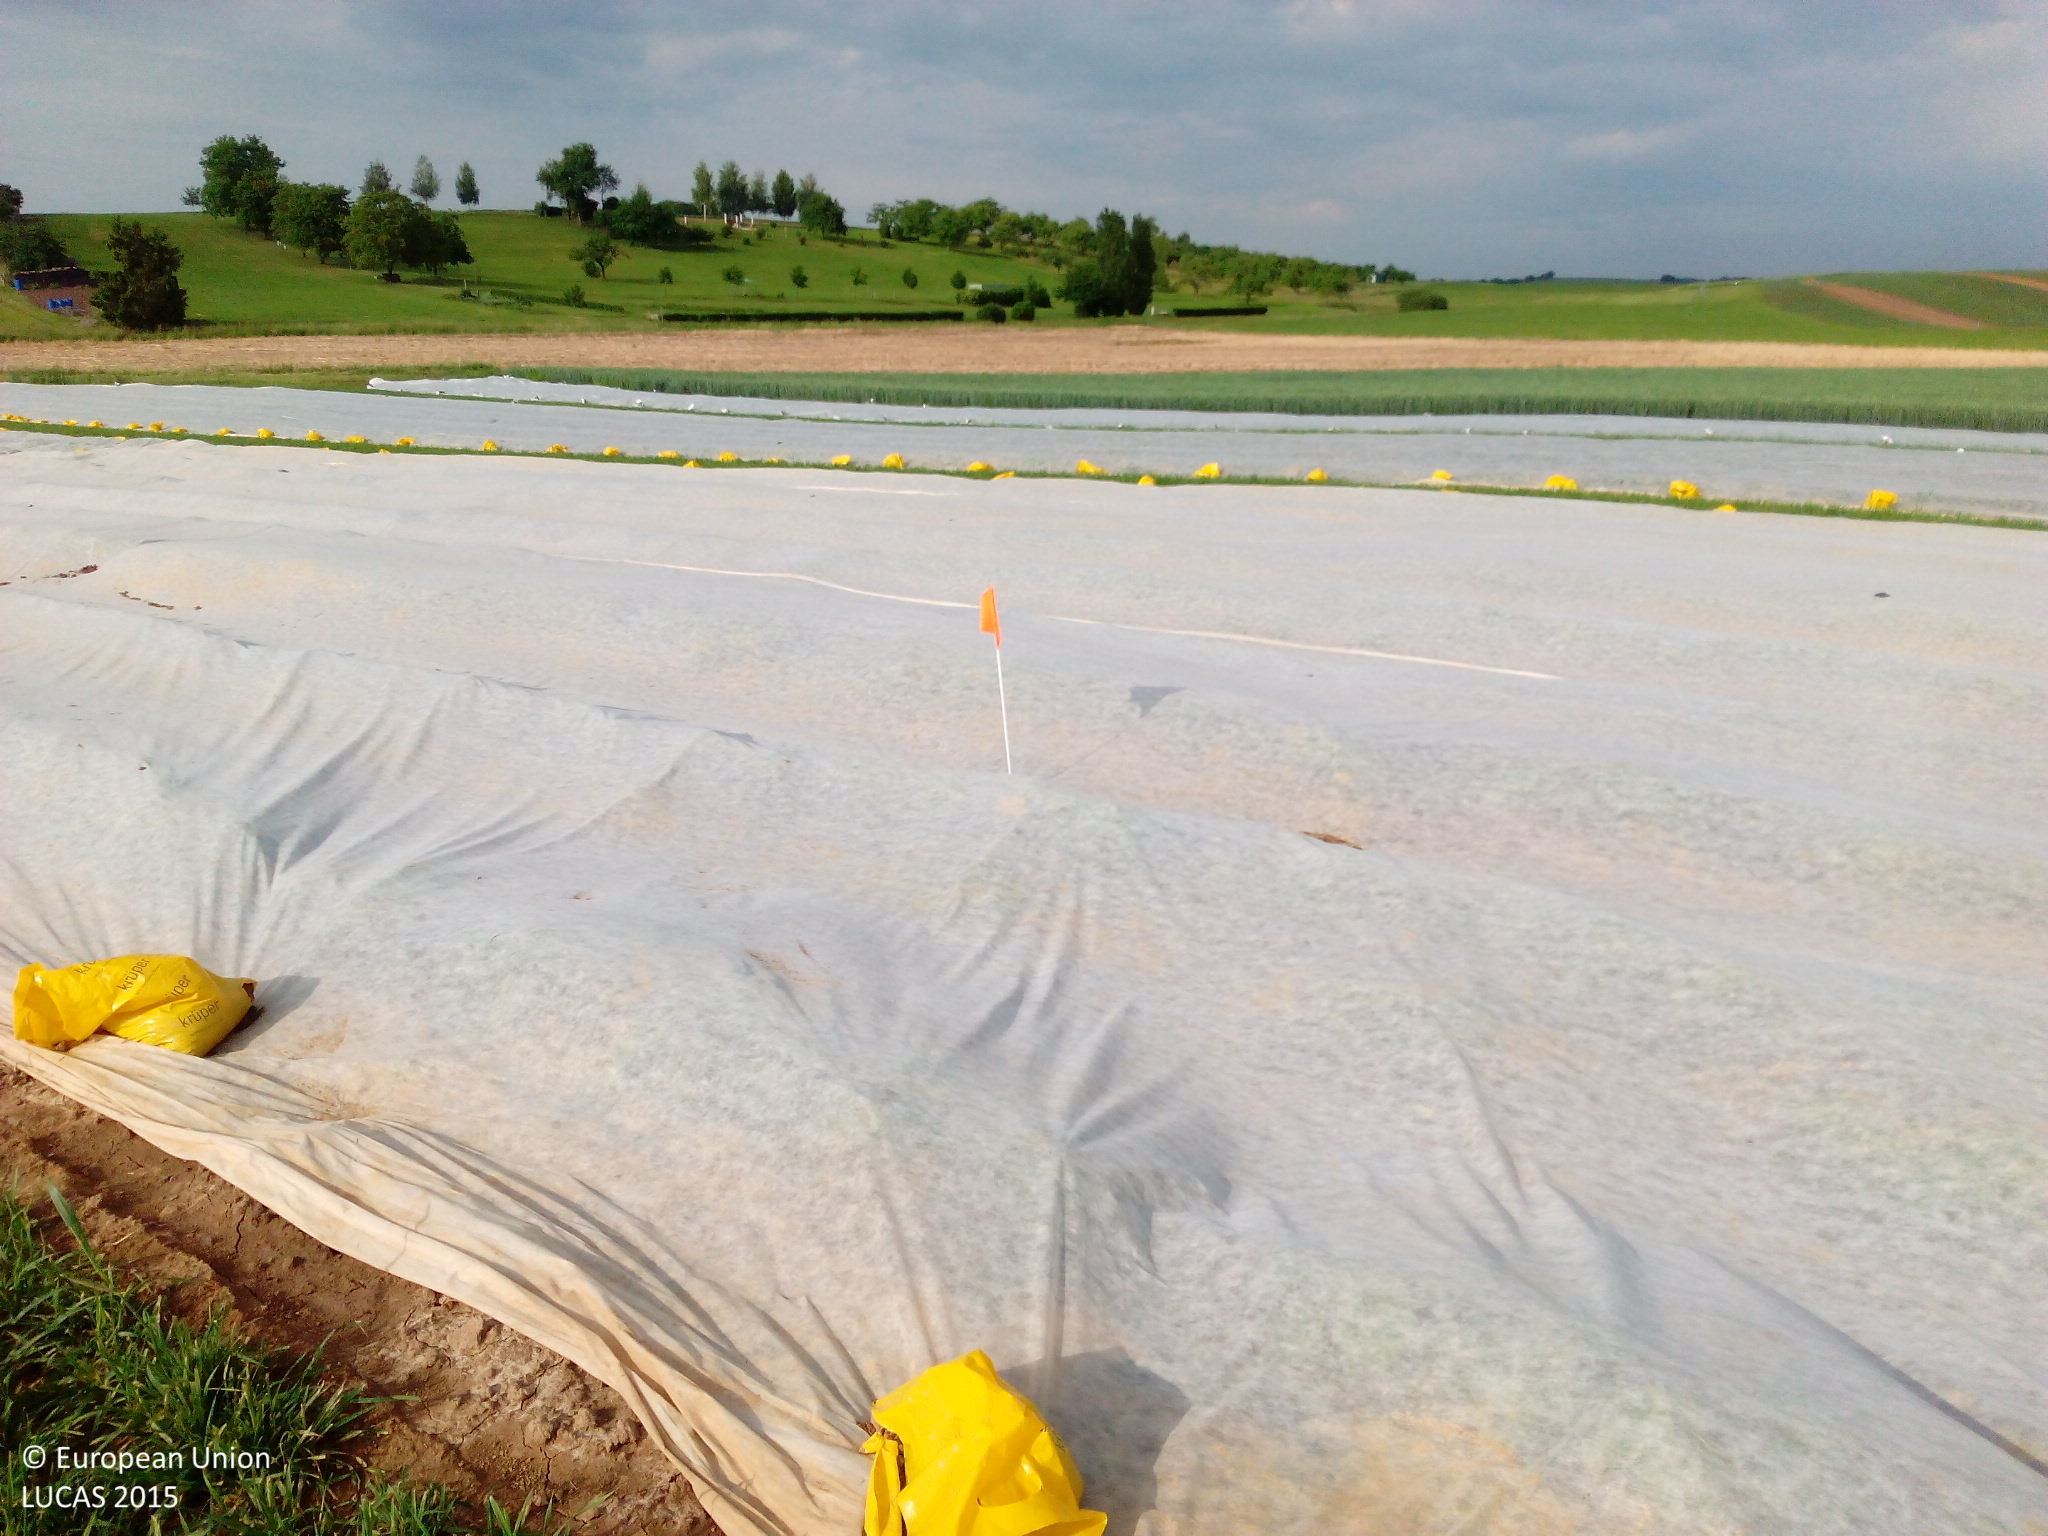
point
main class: Cropland
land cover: Other fresh vegetables
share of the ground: 10 - 25 %
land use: Agriculture (excluding fallow land and kitchen gardens)
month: May
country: DE
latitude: 49.1935
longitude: 9.4102
